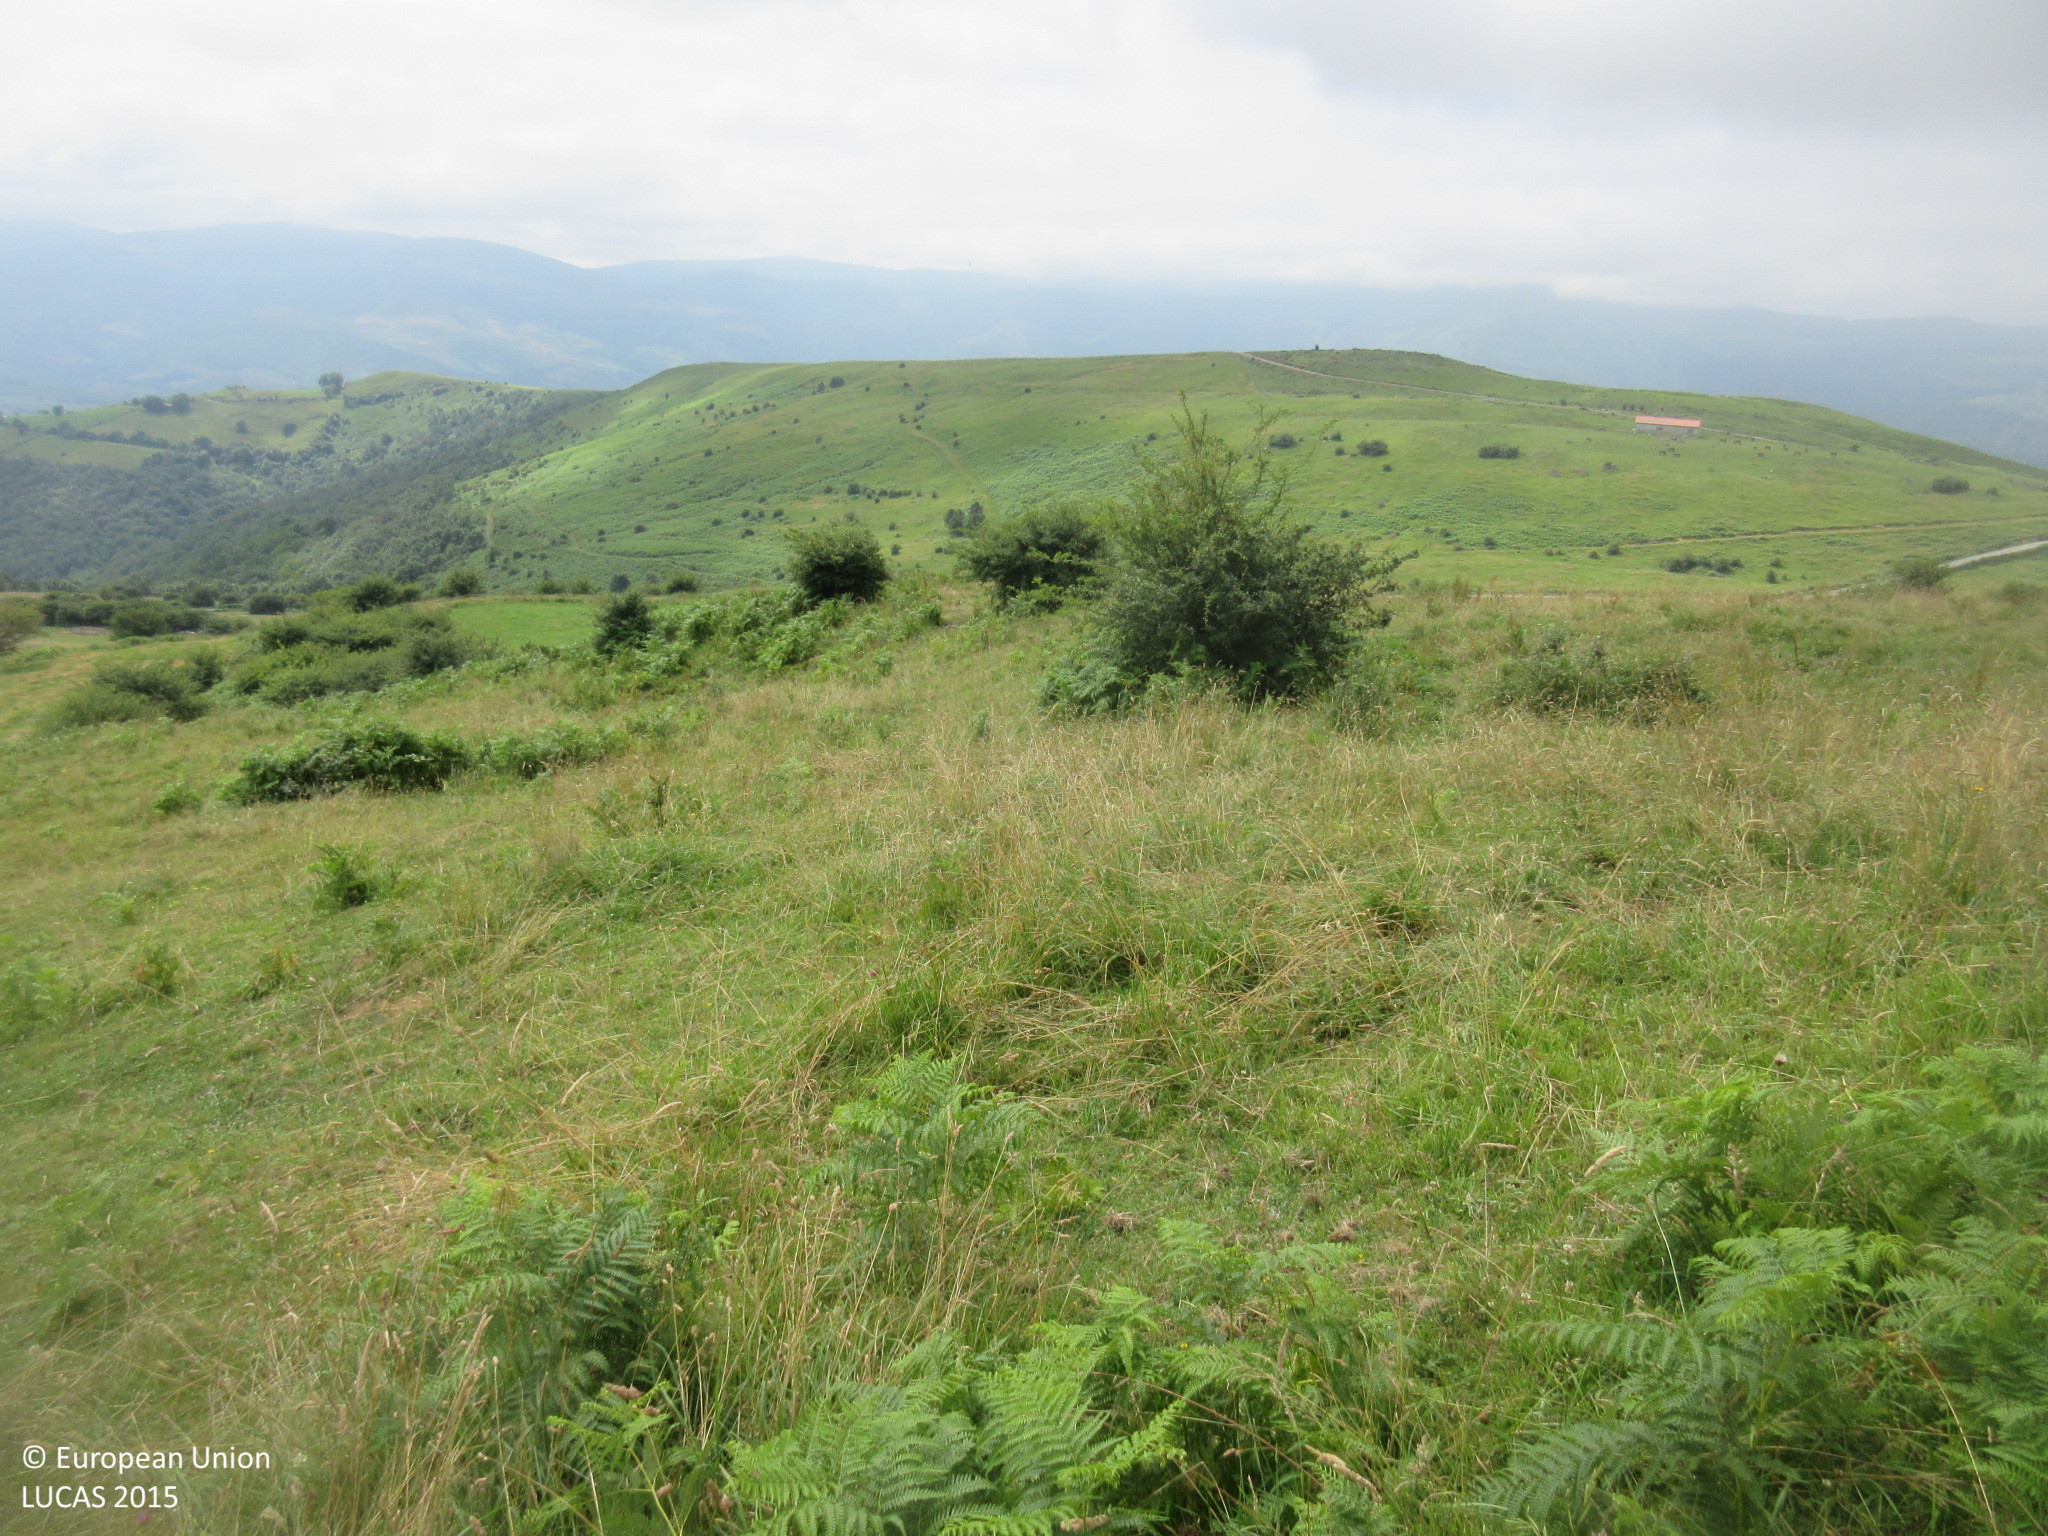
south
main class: Shrubland
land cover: Shrubland without tree cover
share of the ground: > 75 %
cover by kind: shrubs 100 %
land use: Semi-natural and natural areas not in use
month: July
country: ES
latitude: 43.2199
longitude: -3.5476
